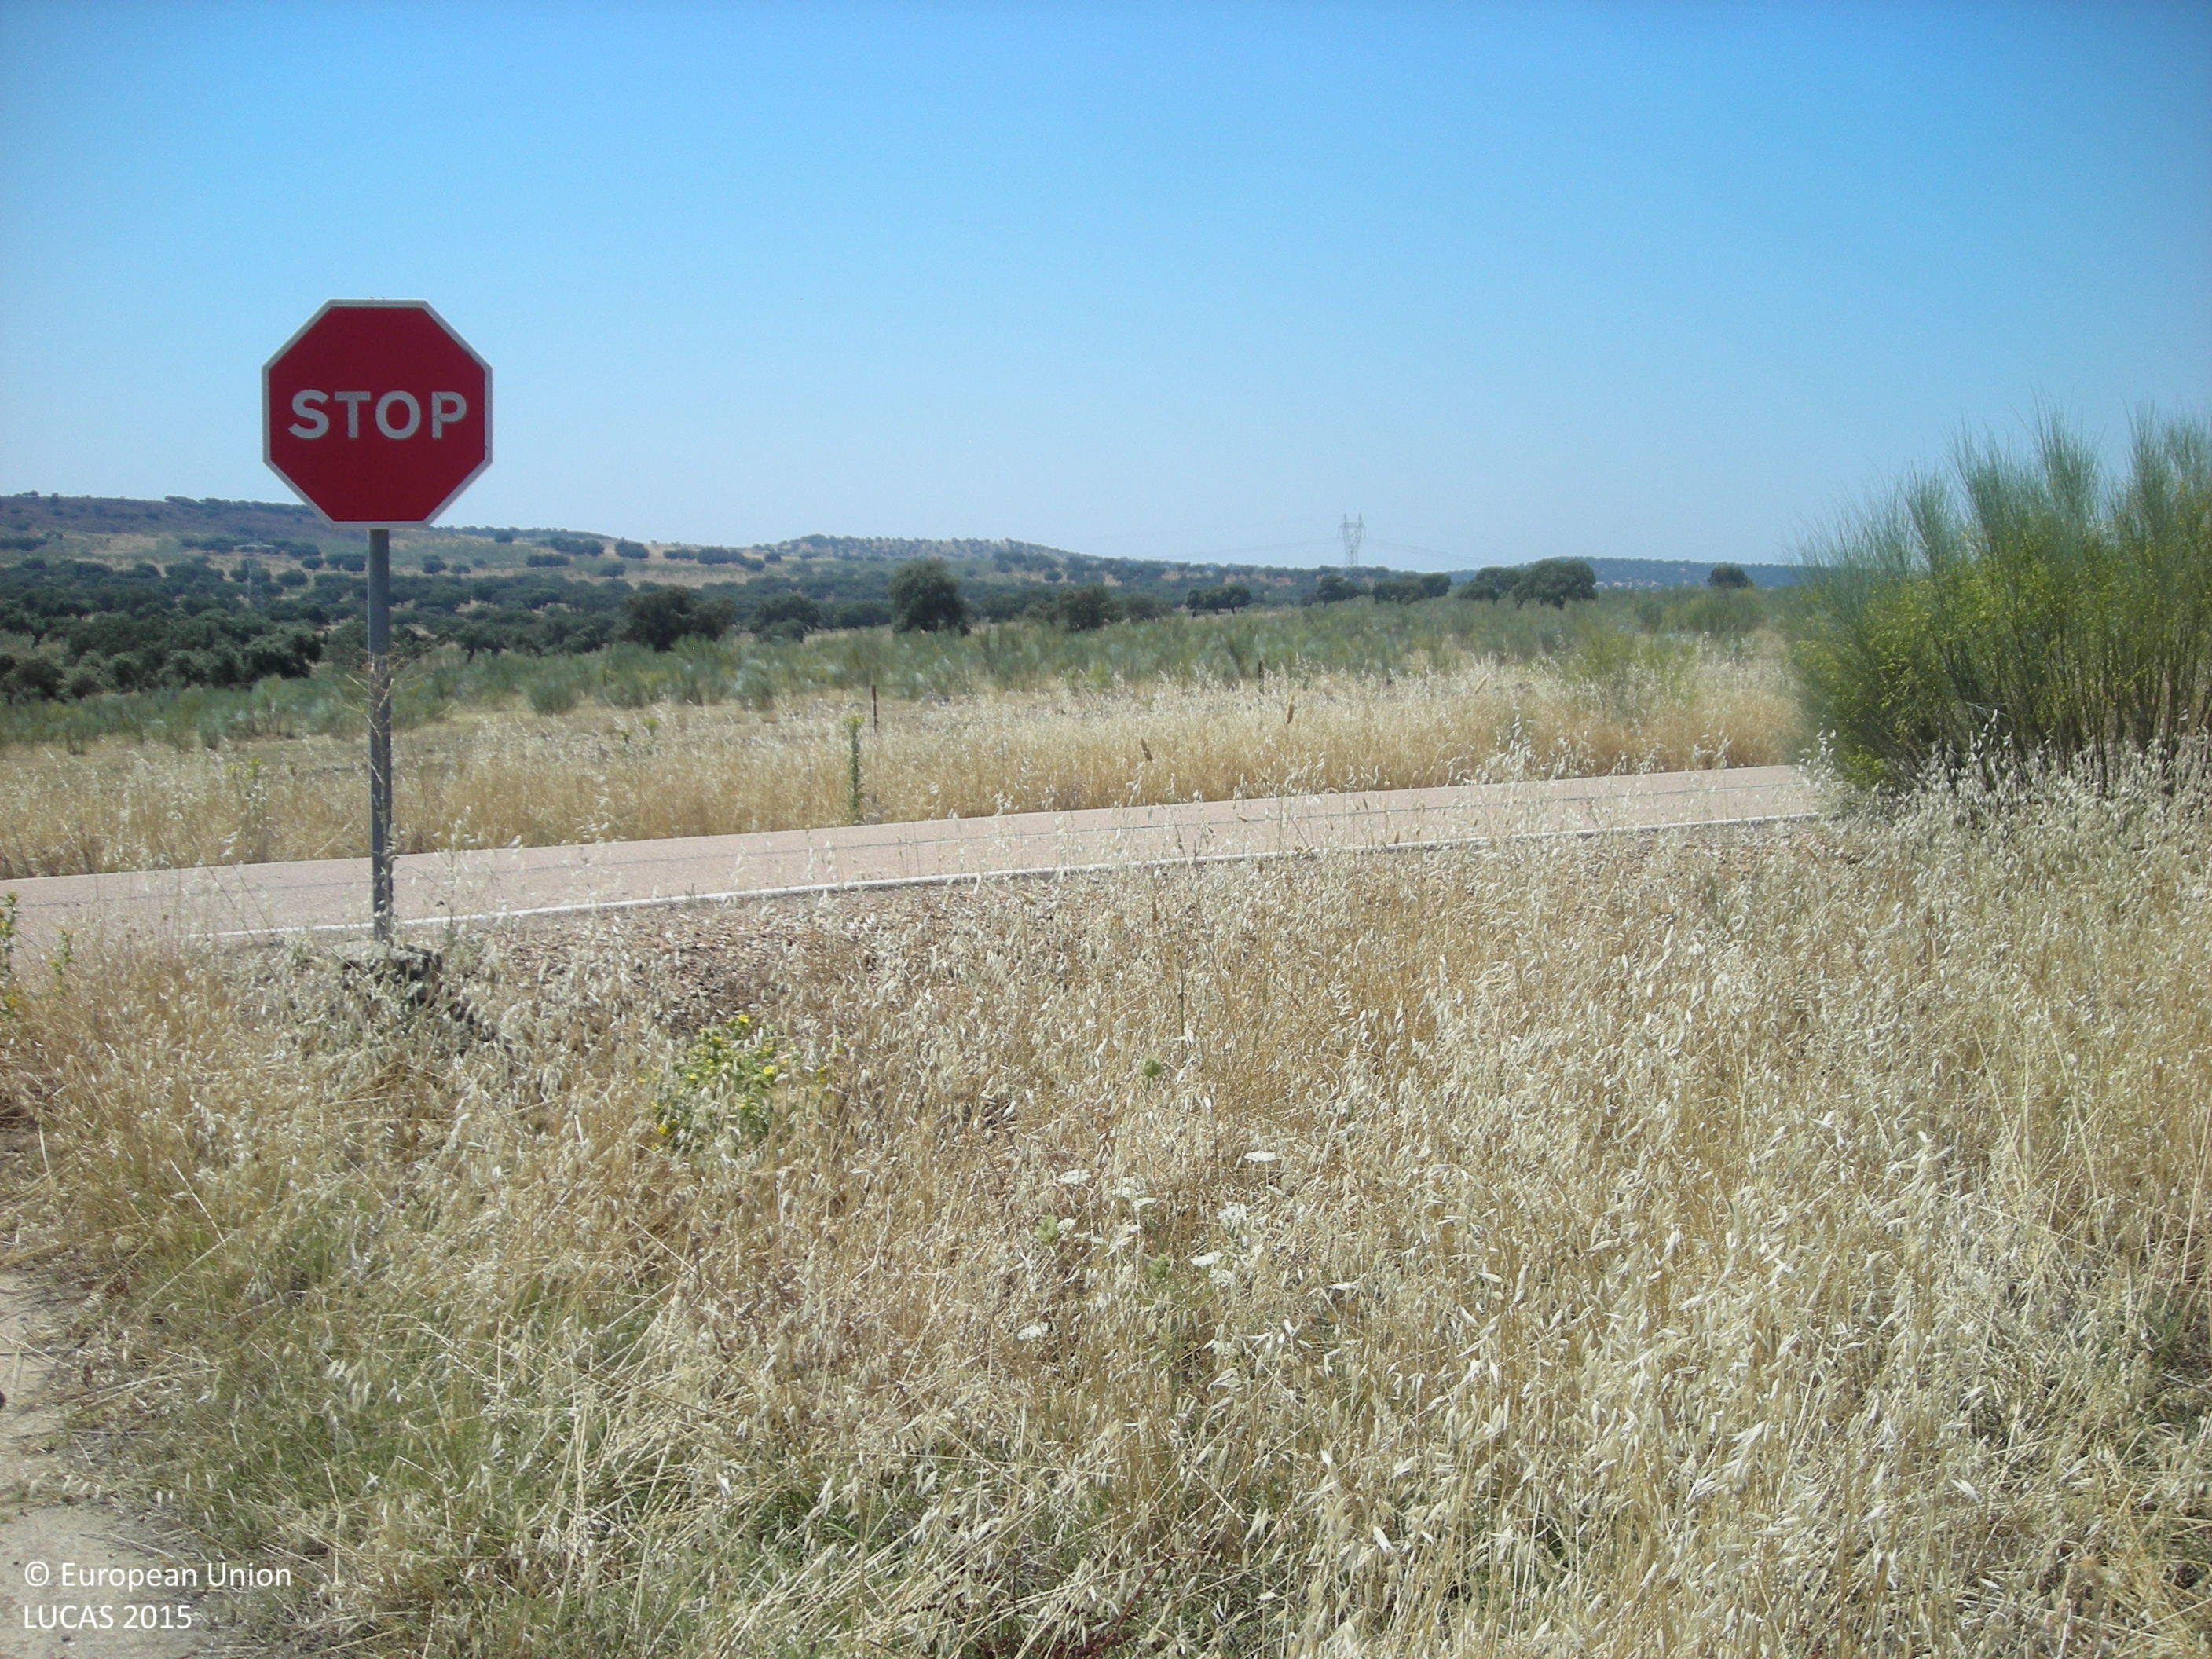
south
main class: Woodland
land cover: Broadleaved woodland
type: broadleaved evergreen forest
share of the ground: 25 - 50 %
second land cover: Grassland without tree/shrub cover
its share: 50 - 75 %
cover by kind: shrubs 60 %, broadleaved forest trees 40 %
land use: Forestry
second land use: Agriculture (excluding fallow land and kitchen gardens)
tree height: > 5 m
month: June
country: ES
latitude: 39.2451
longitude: -5.5164
